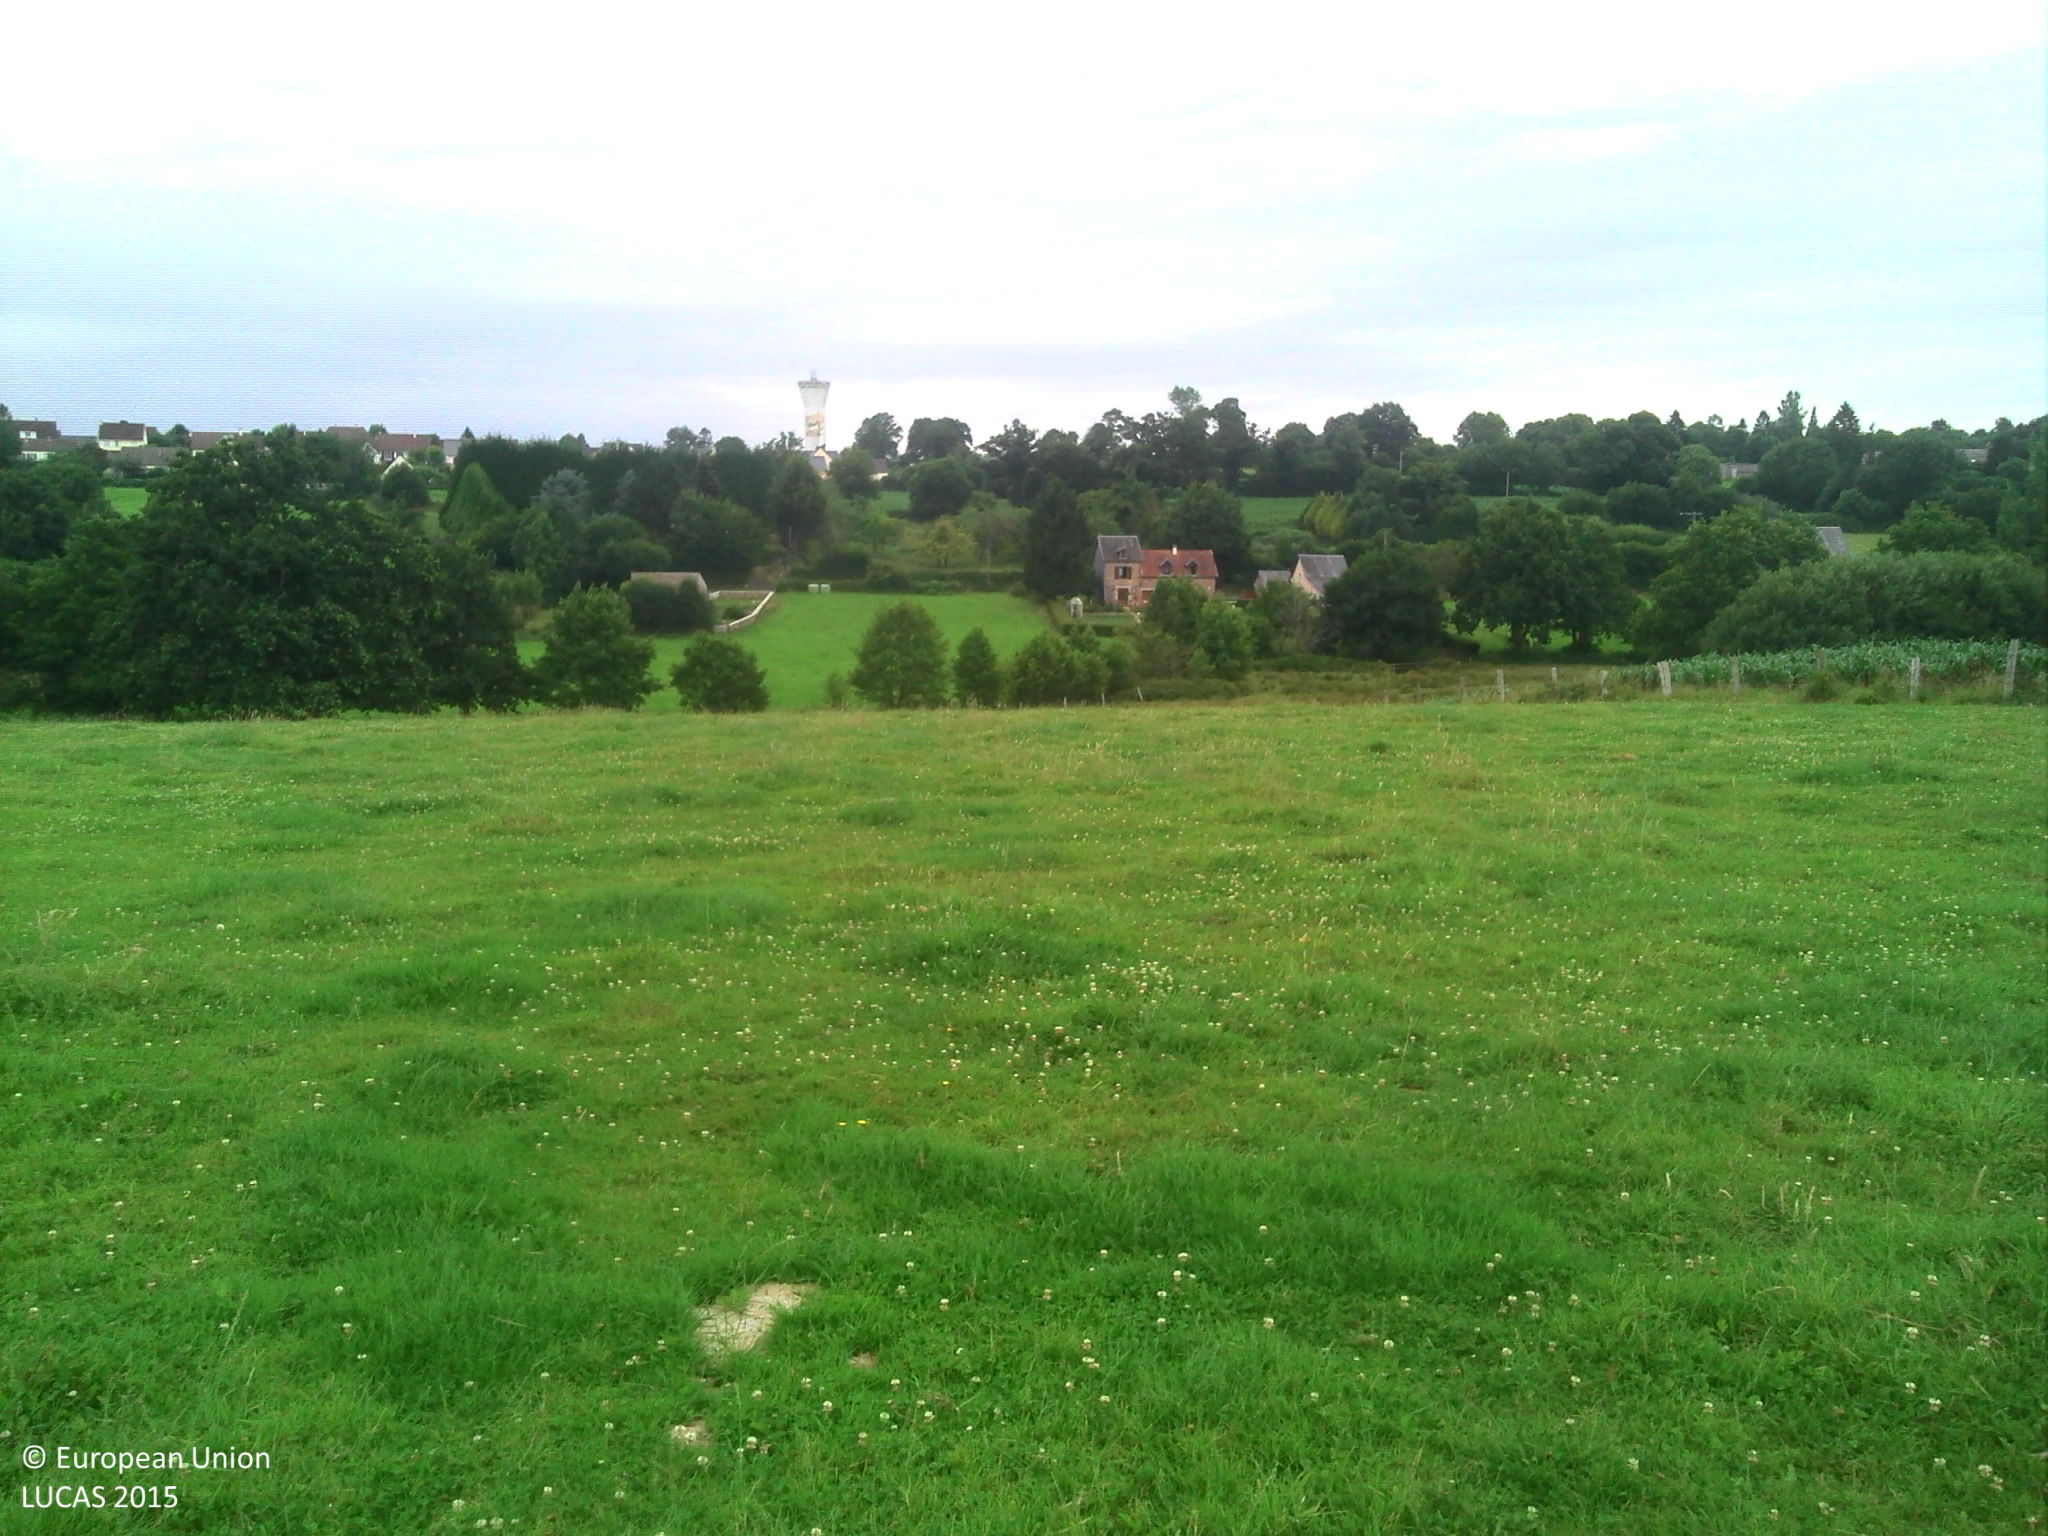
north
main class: Grassland
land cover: Grassland without tree/shrub cover
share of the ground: > 75 %
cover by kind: herbaceous plants 100 %
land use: Agriculture (excluding fallow land and kitchen gardens)
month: July
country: FR
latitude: 48.7943
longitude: -1.3858
